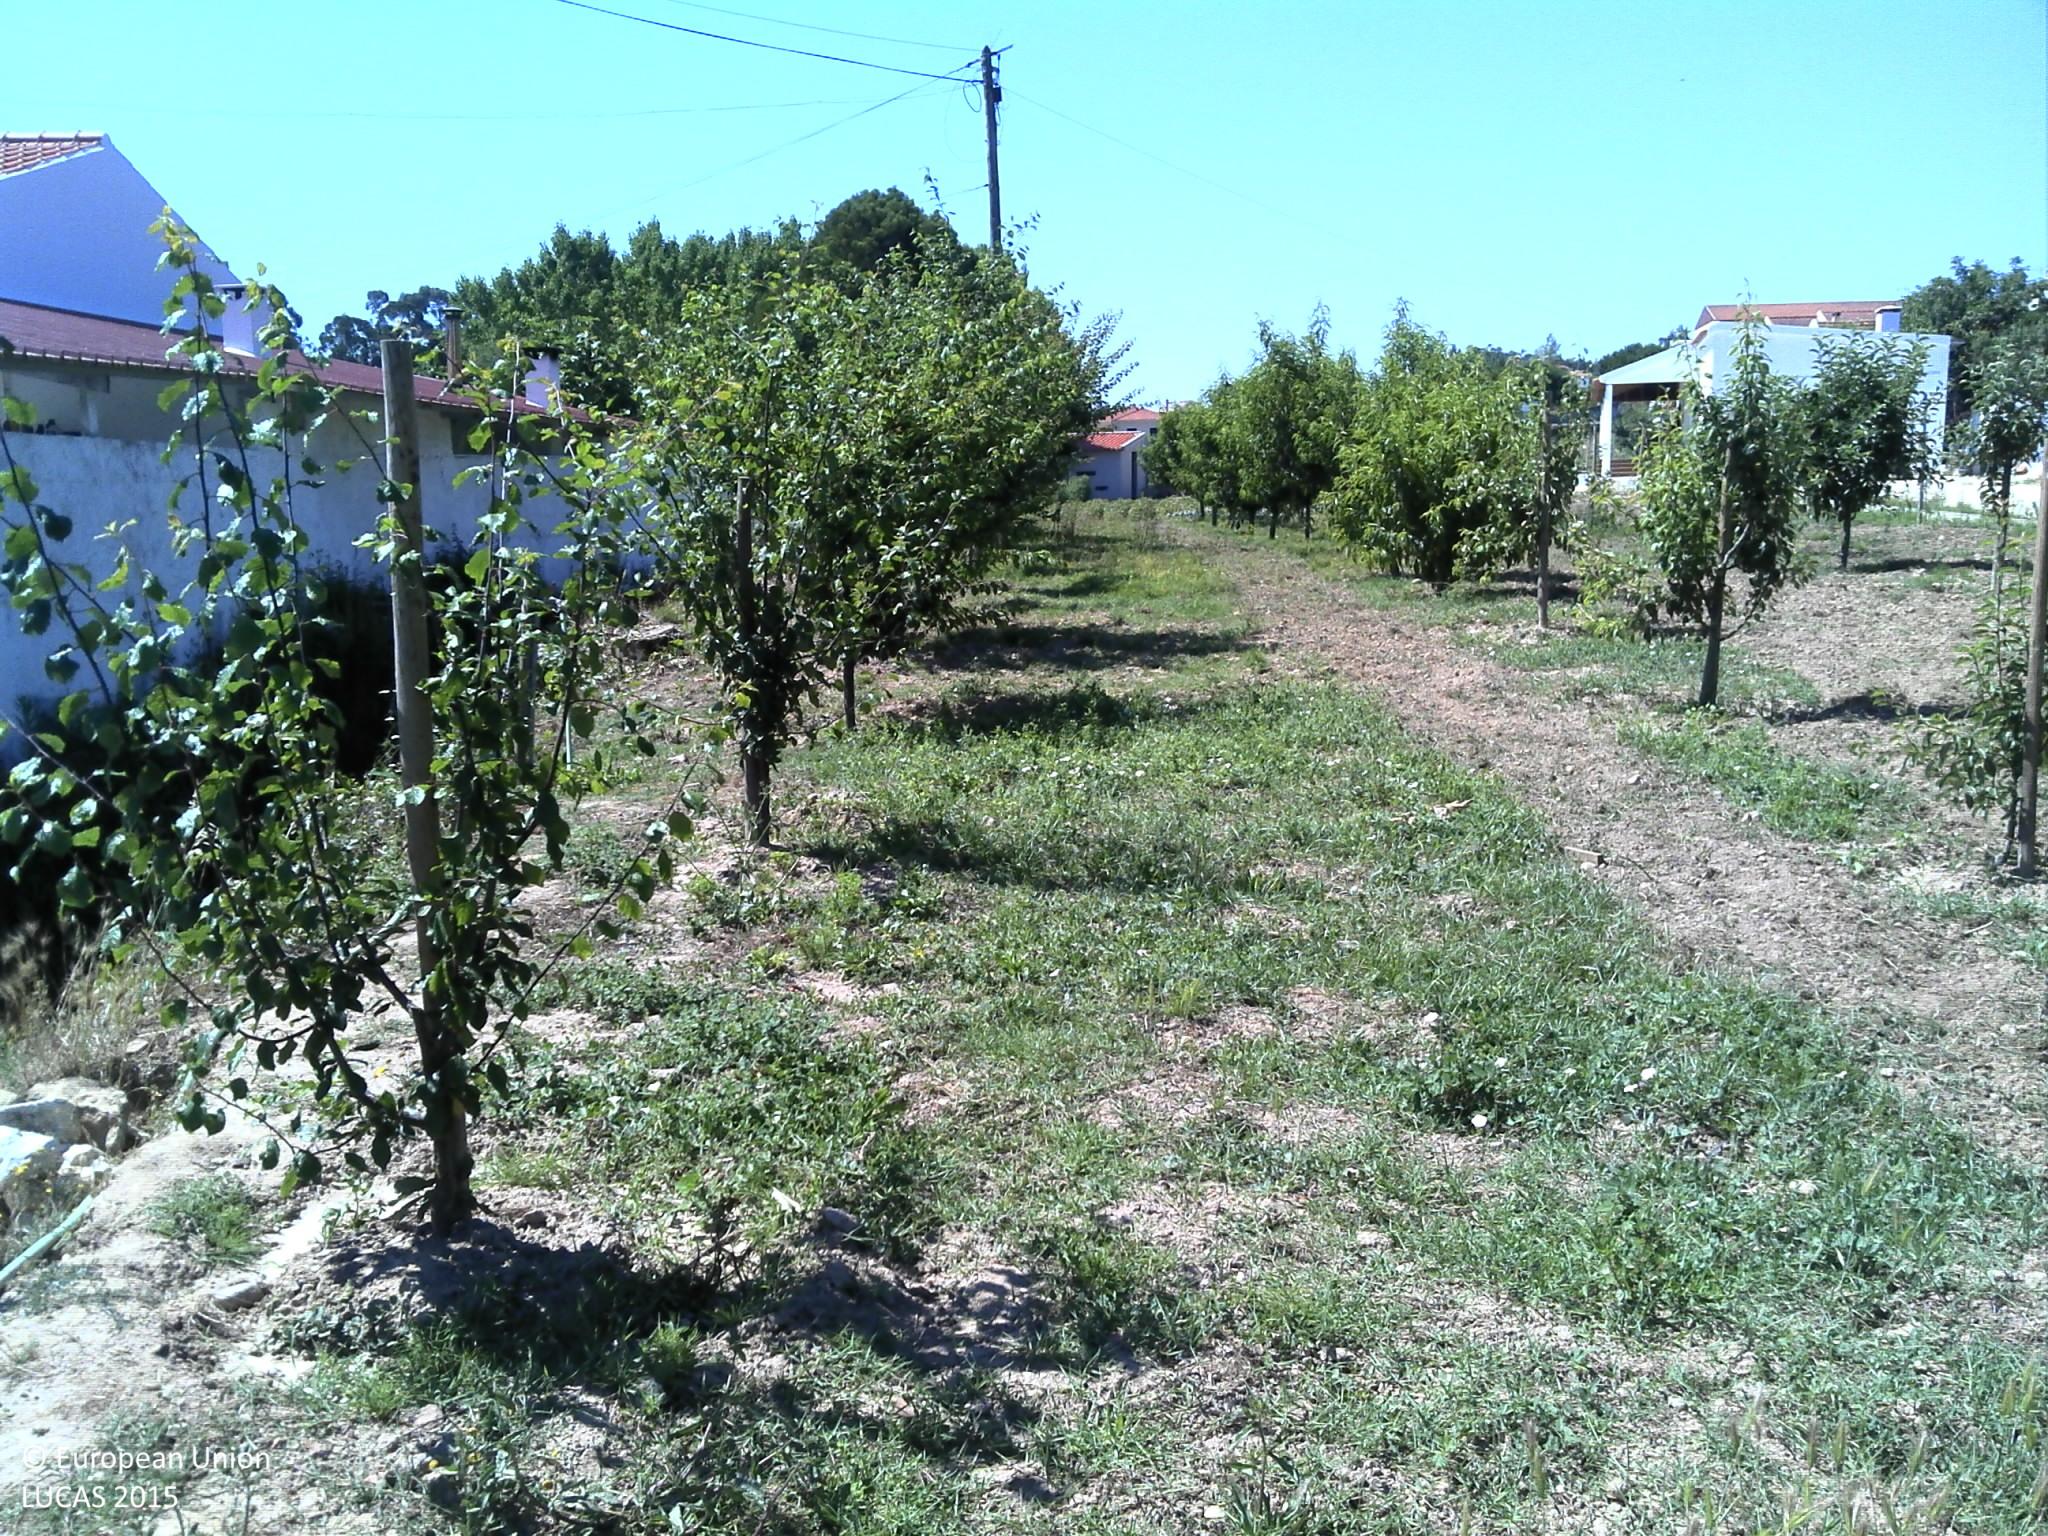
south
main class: Cropland
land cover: Other fruit trees and berries
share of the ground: 25 - 50 %
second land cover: Grassland without tree/shrub cover
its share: 50 - 75 %
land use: Kitchen garden
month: June
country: PT
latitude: 39.1408
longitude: -9.2343
